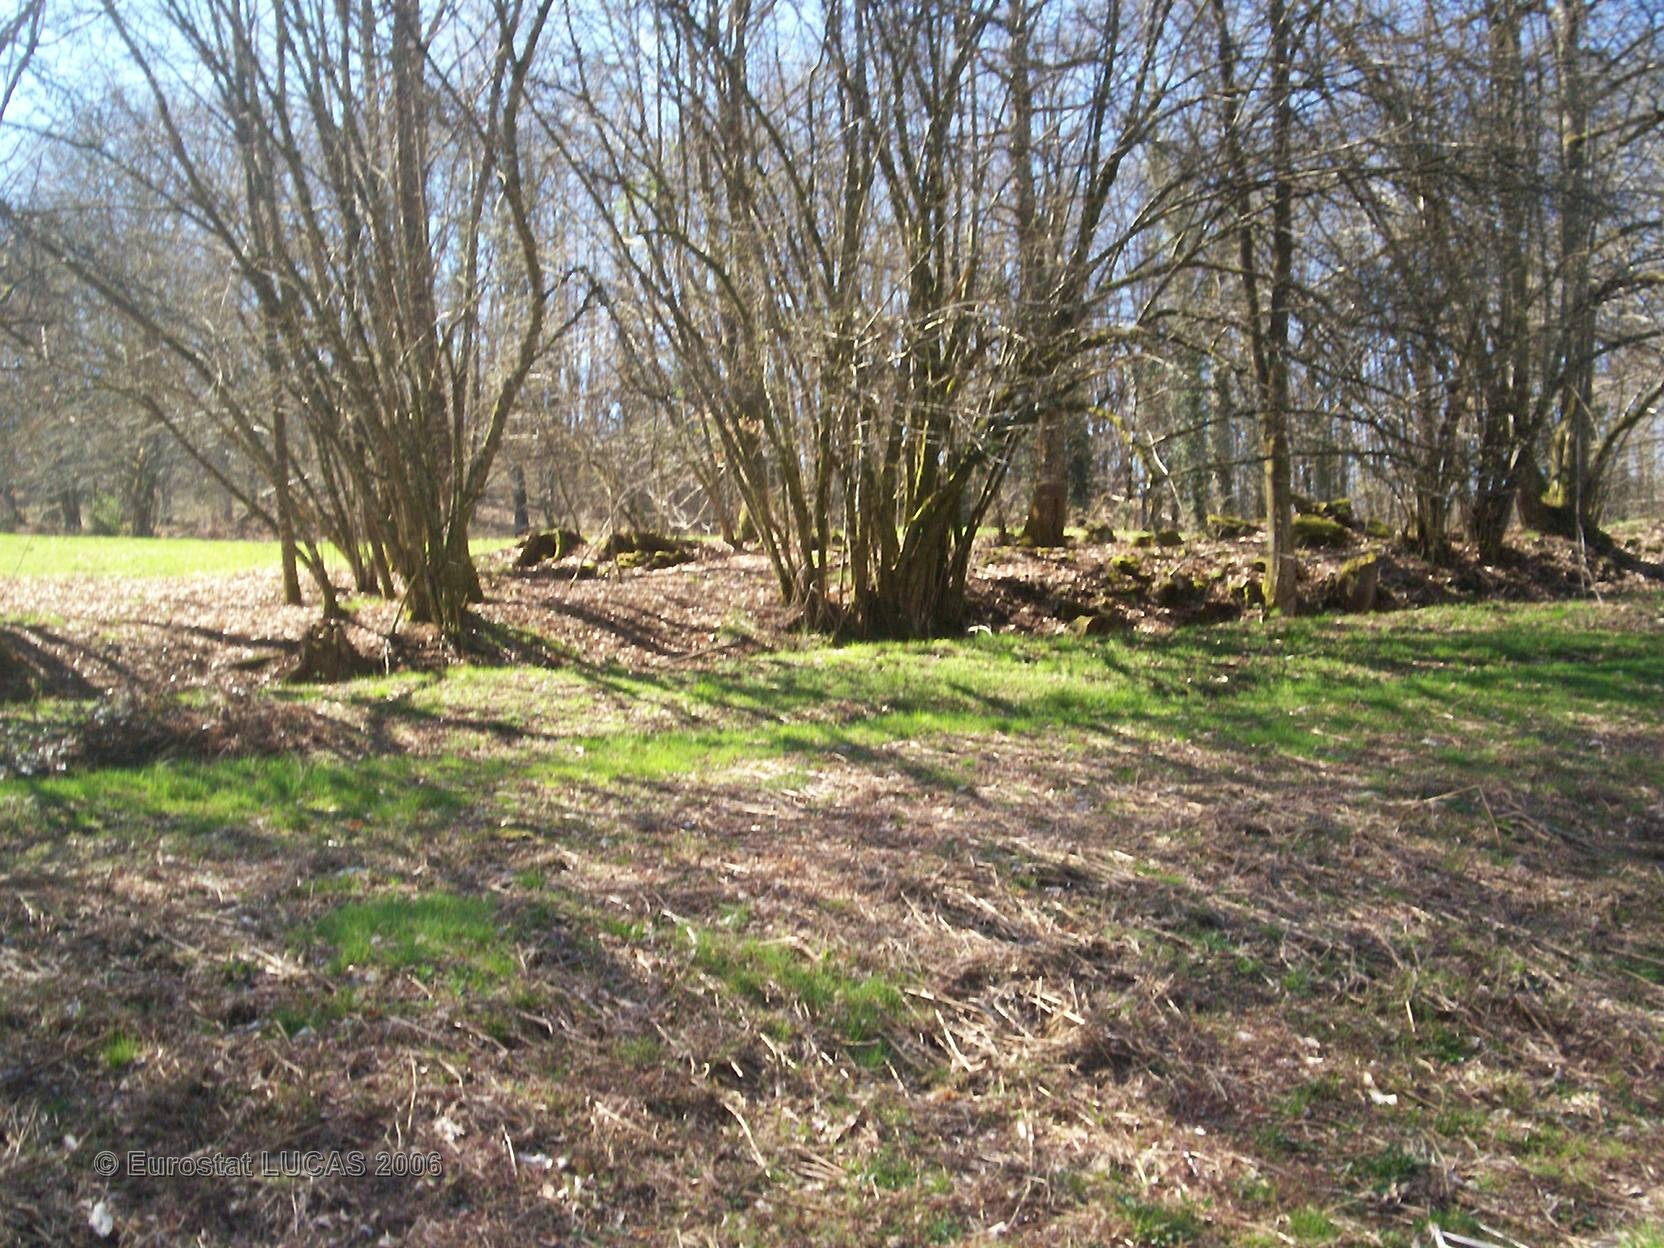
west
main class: Grassland
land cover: Grassland with sparse tree/shrub cover
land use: Unused
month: April
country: FR
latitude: 45.2994
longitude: 1.6424
